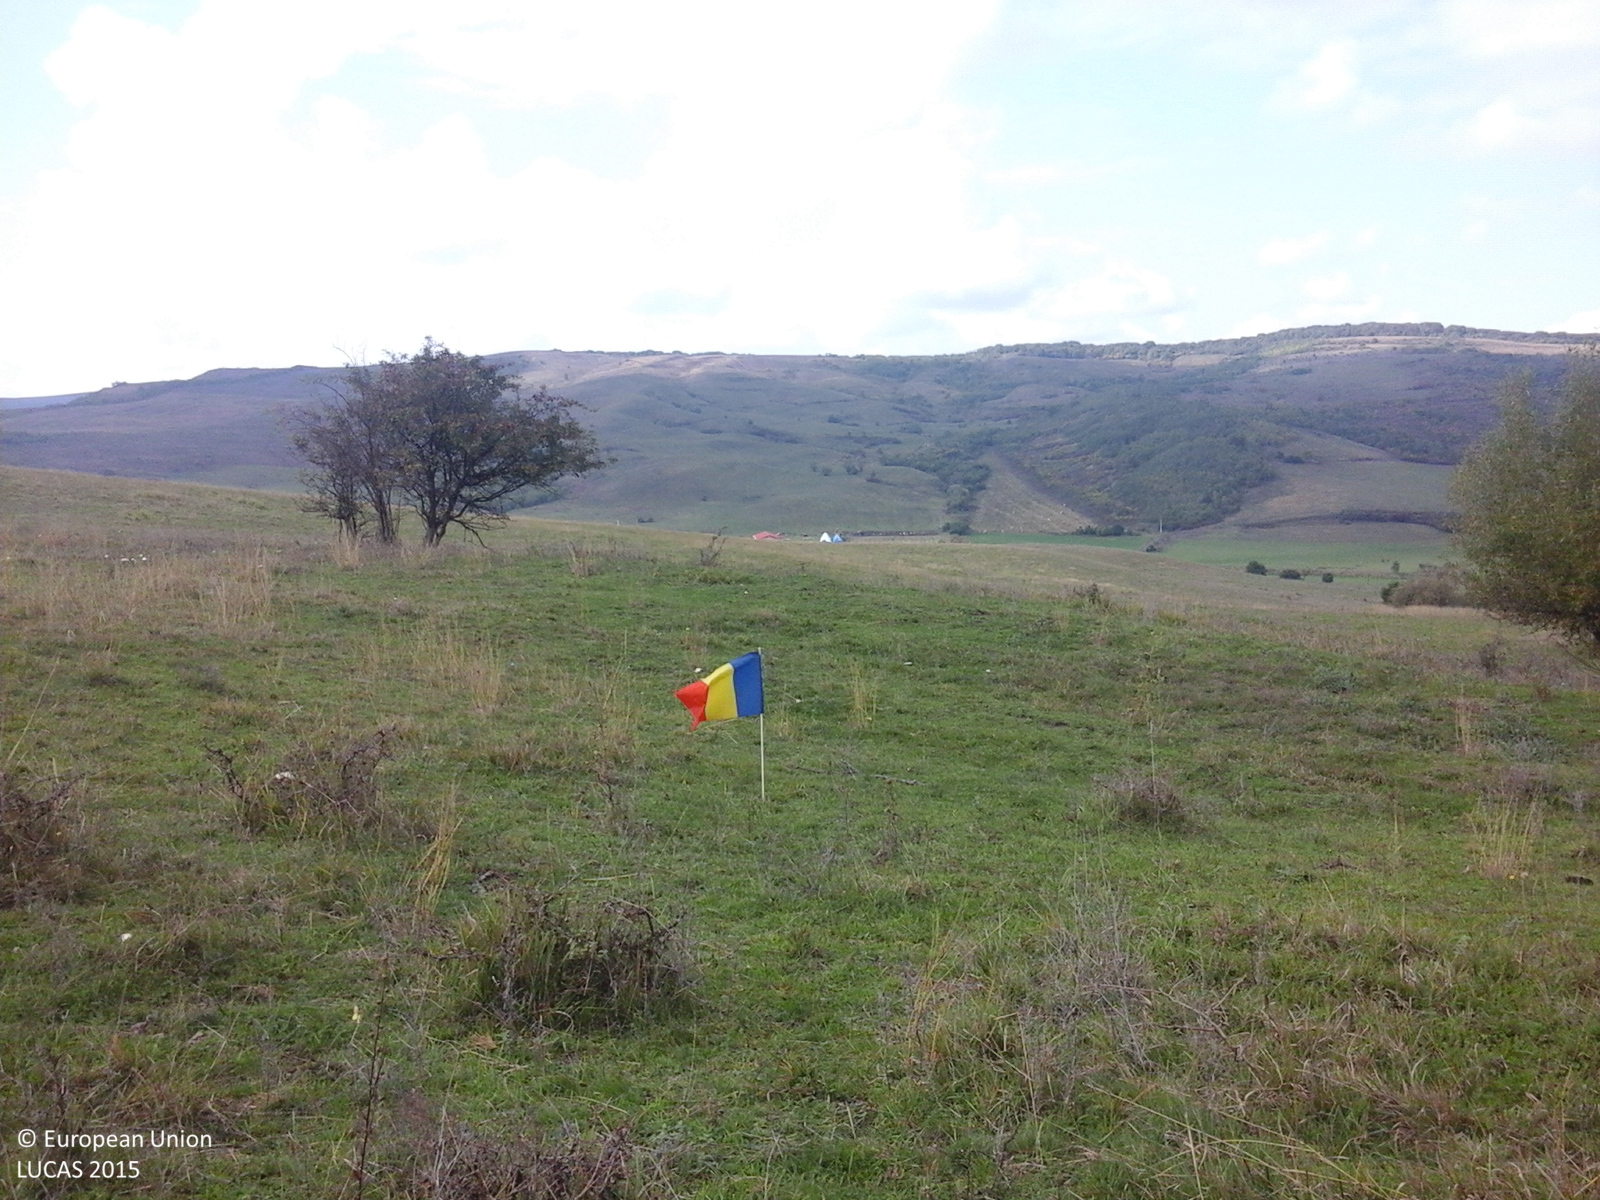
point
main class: Grassland
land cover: Grassland without tree/shrub cover
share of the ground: > 75 %
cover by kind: herbaceous plants 100 %
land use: Agriculture (excluding fallow land and kitchen gardens)
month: October
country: RO
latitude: 46.0370
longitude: 24.0685
